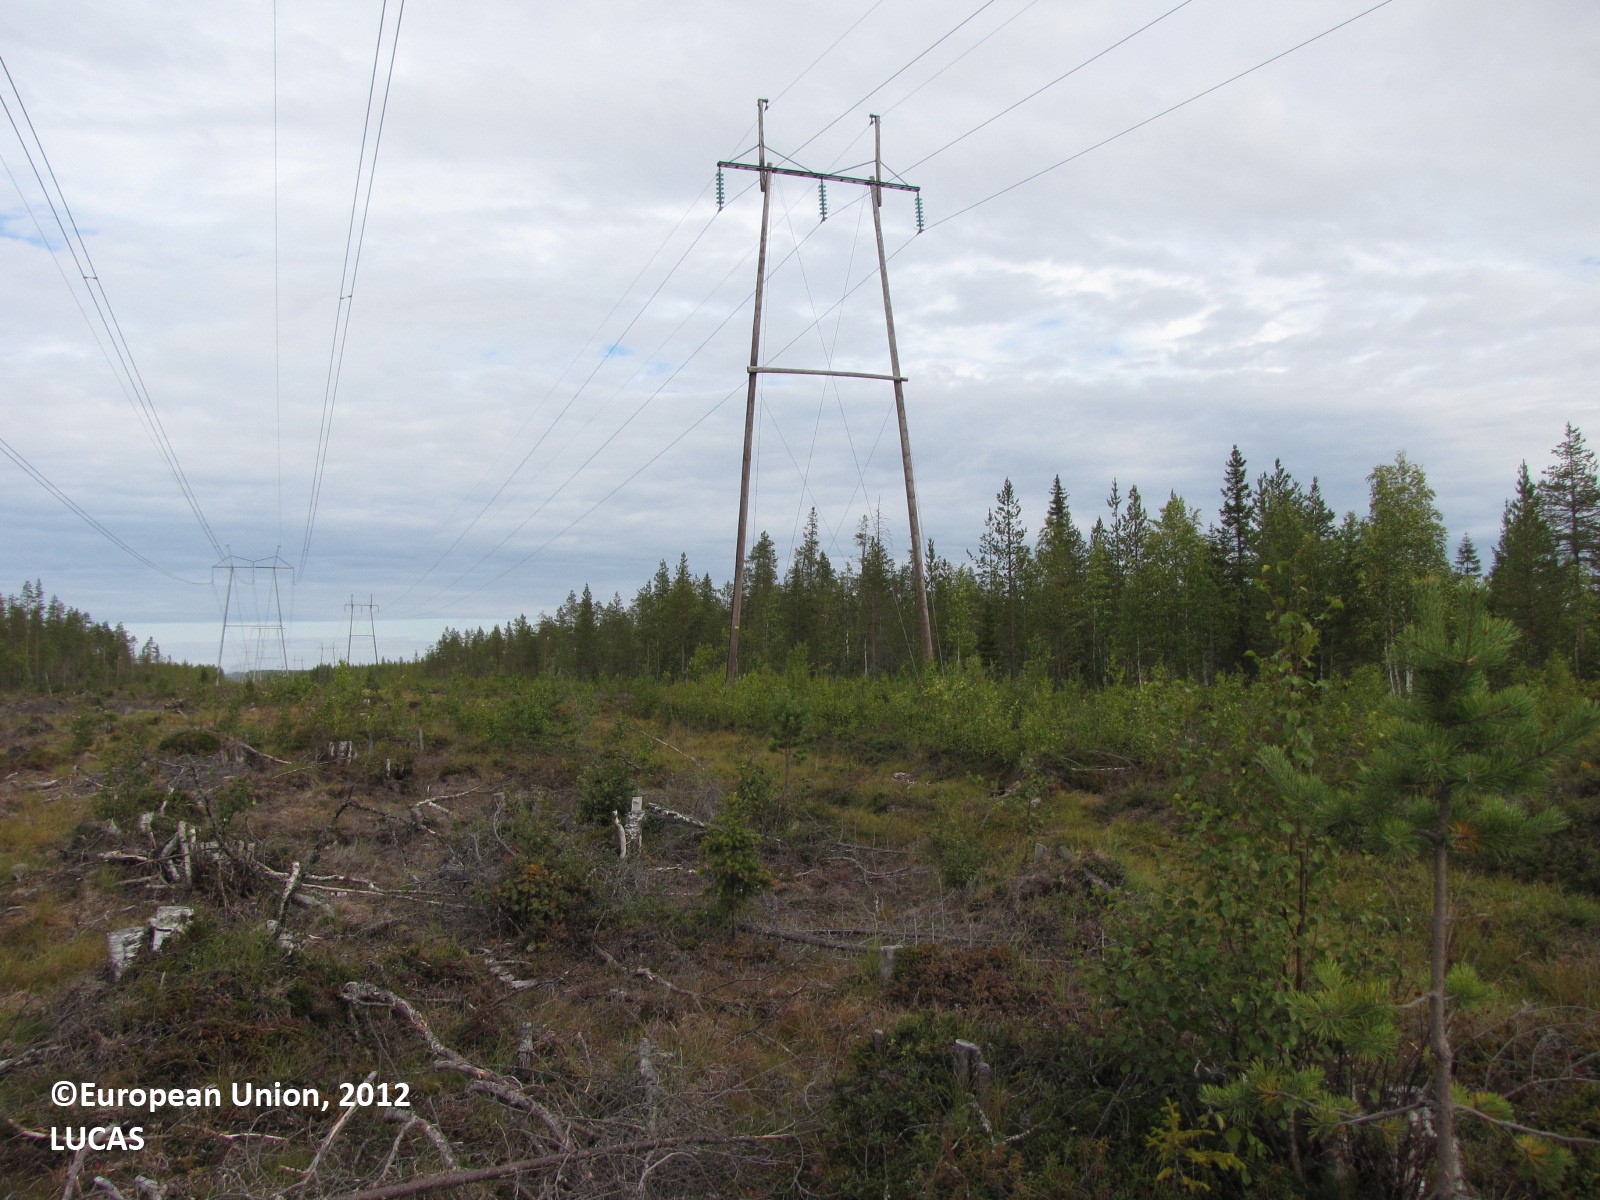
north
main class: Shrubland
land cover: Shrubland with sparse tree cover
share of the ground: > 75 %
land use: Energy production
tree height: < 5 m
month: August
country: FI
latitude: 67.1107
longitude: 25.0917
